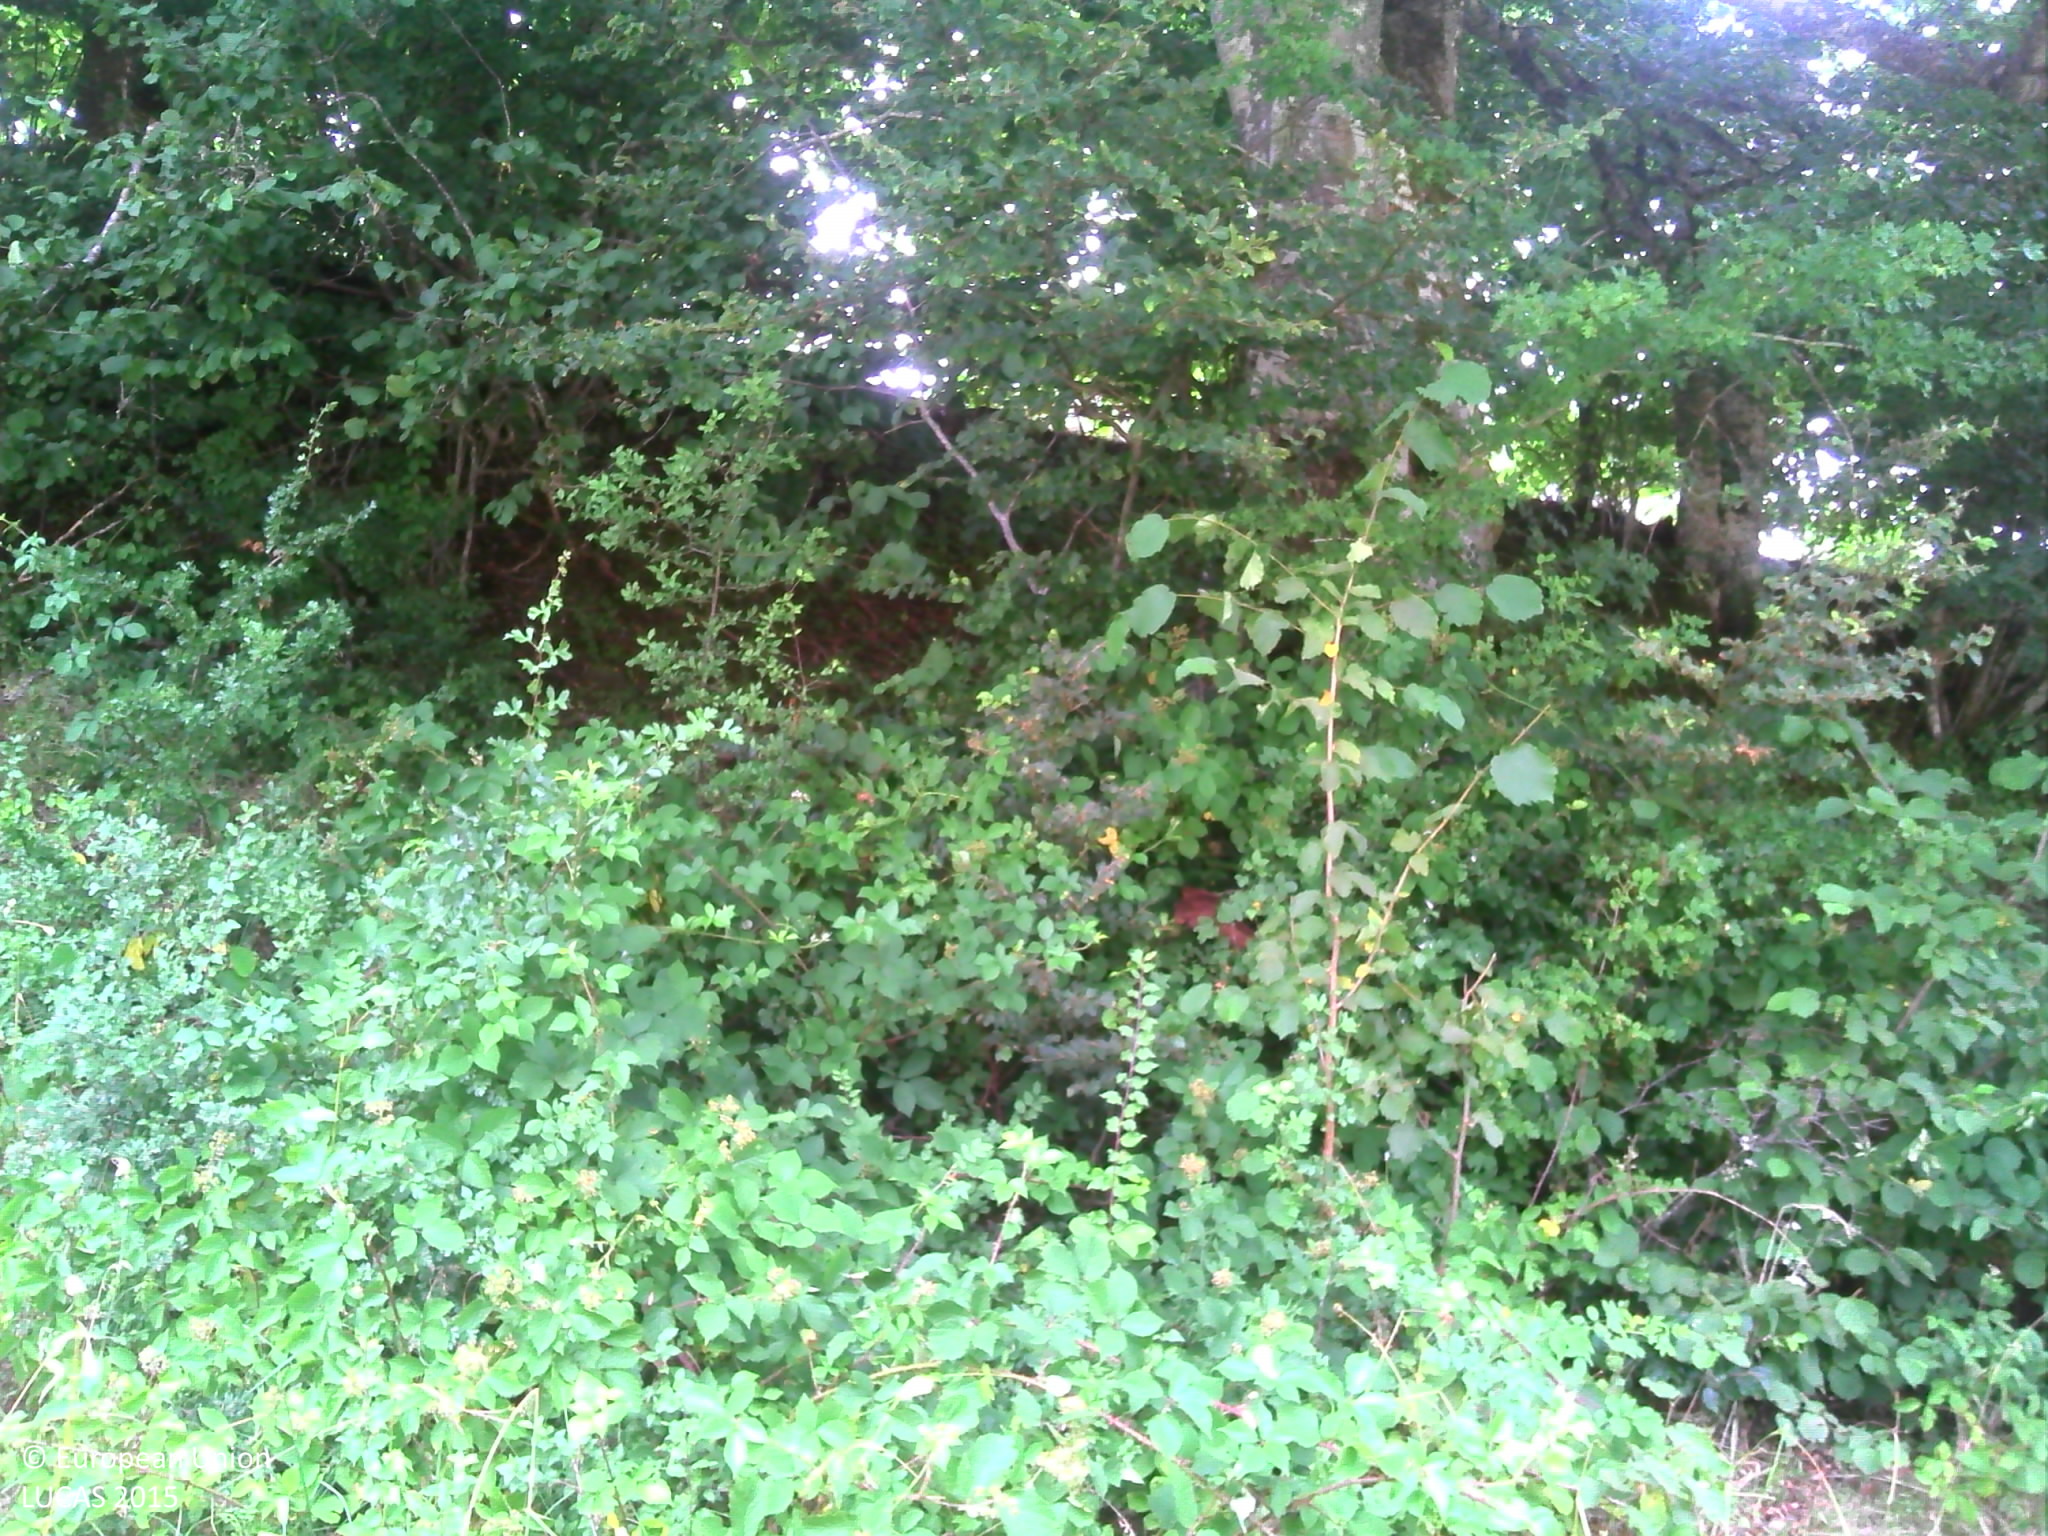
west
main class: Grassland
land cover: Grassland with sparse tree/shrub cover
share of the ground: > 75 %
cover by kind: herbaceous plants 95 %, broadleaved forest trees 5 %
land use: Agriculture (excluding fallow land and kitchen gardens)
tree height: > 5 m
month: July
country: FR
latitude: 44.8058
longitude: 3.0619
